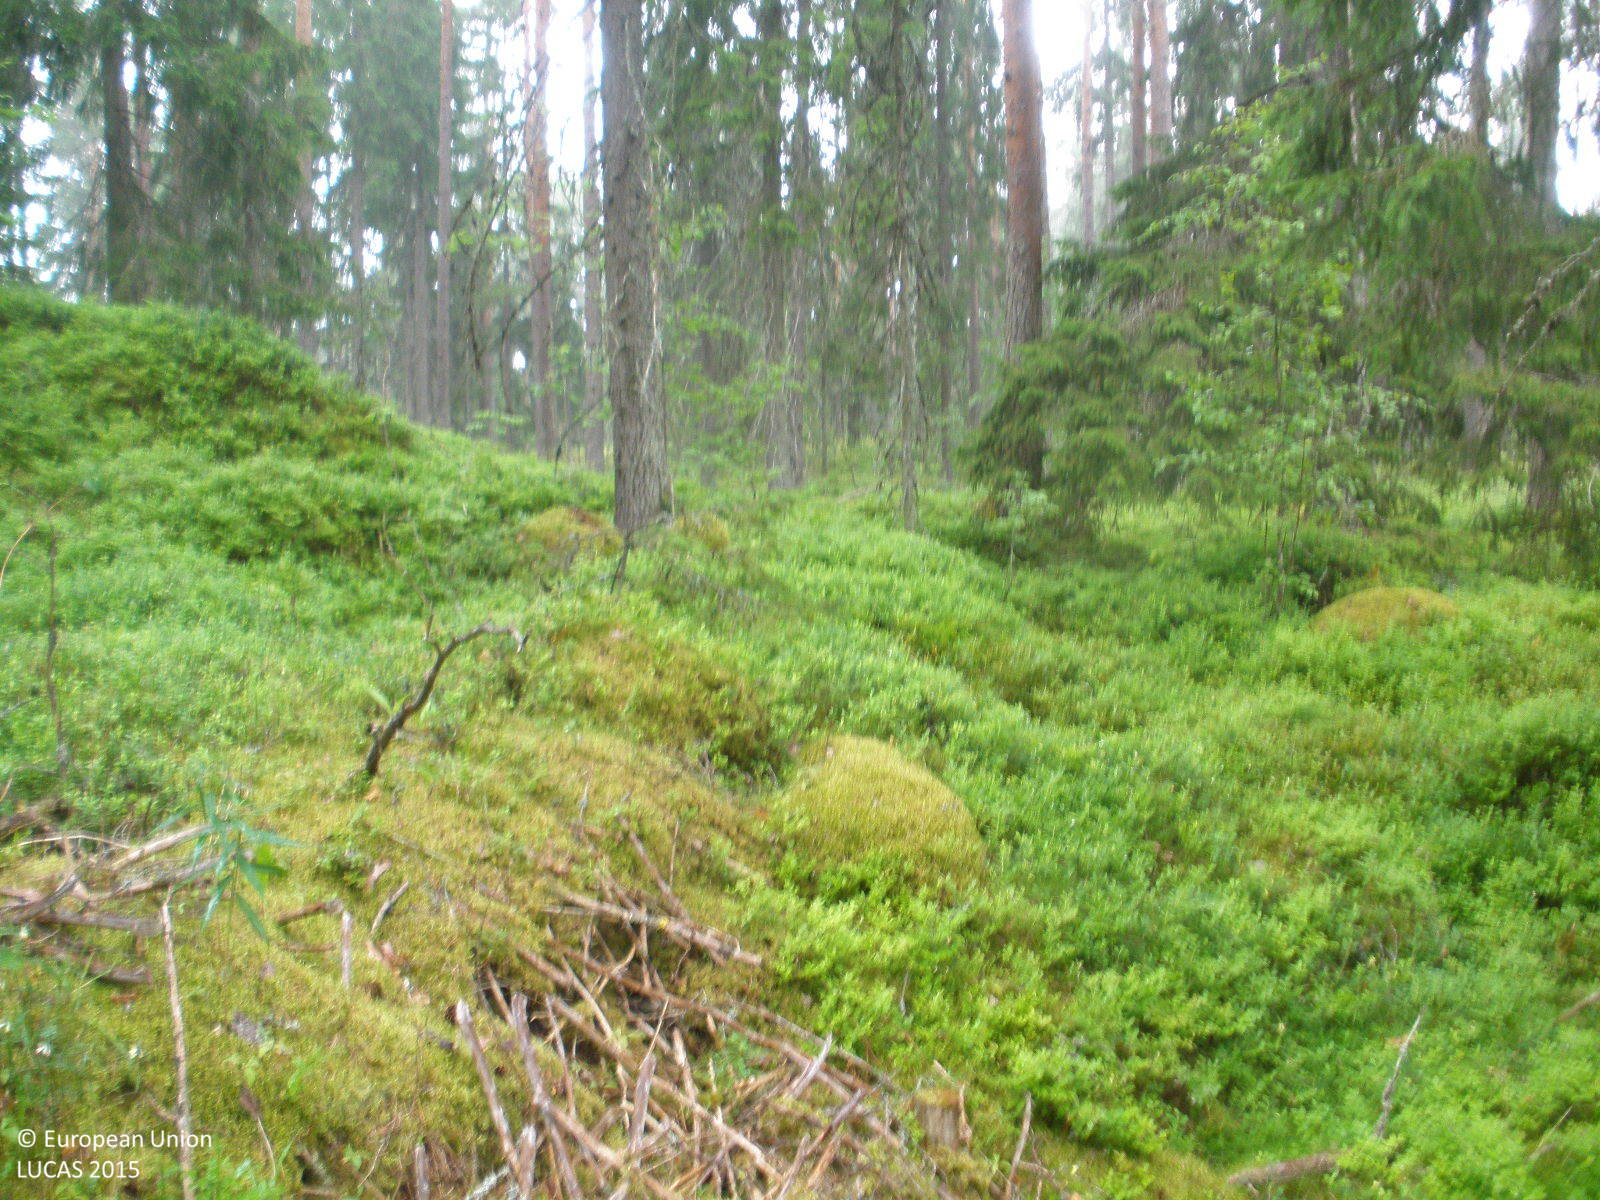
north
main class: Woodland
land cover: Pine dominated coniferous woodland
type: boreal forest
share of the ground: > 75 %
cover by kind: coniferous forest trees 75 %, shrubs 10 %, lichens and mosses 10 %, herbaceous plants 5 %
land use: Forestry
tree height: > 5 m
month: July
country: FI
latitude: 61.3659
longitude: 24.5609
